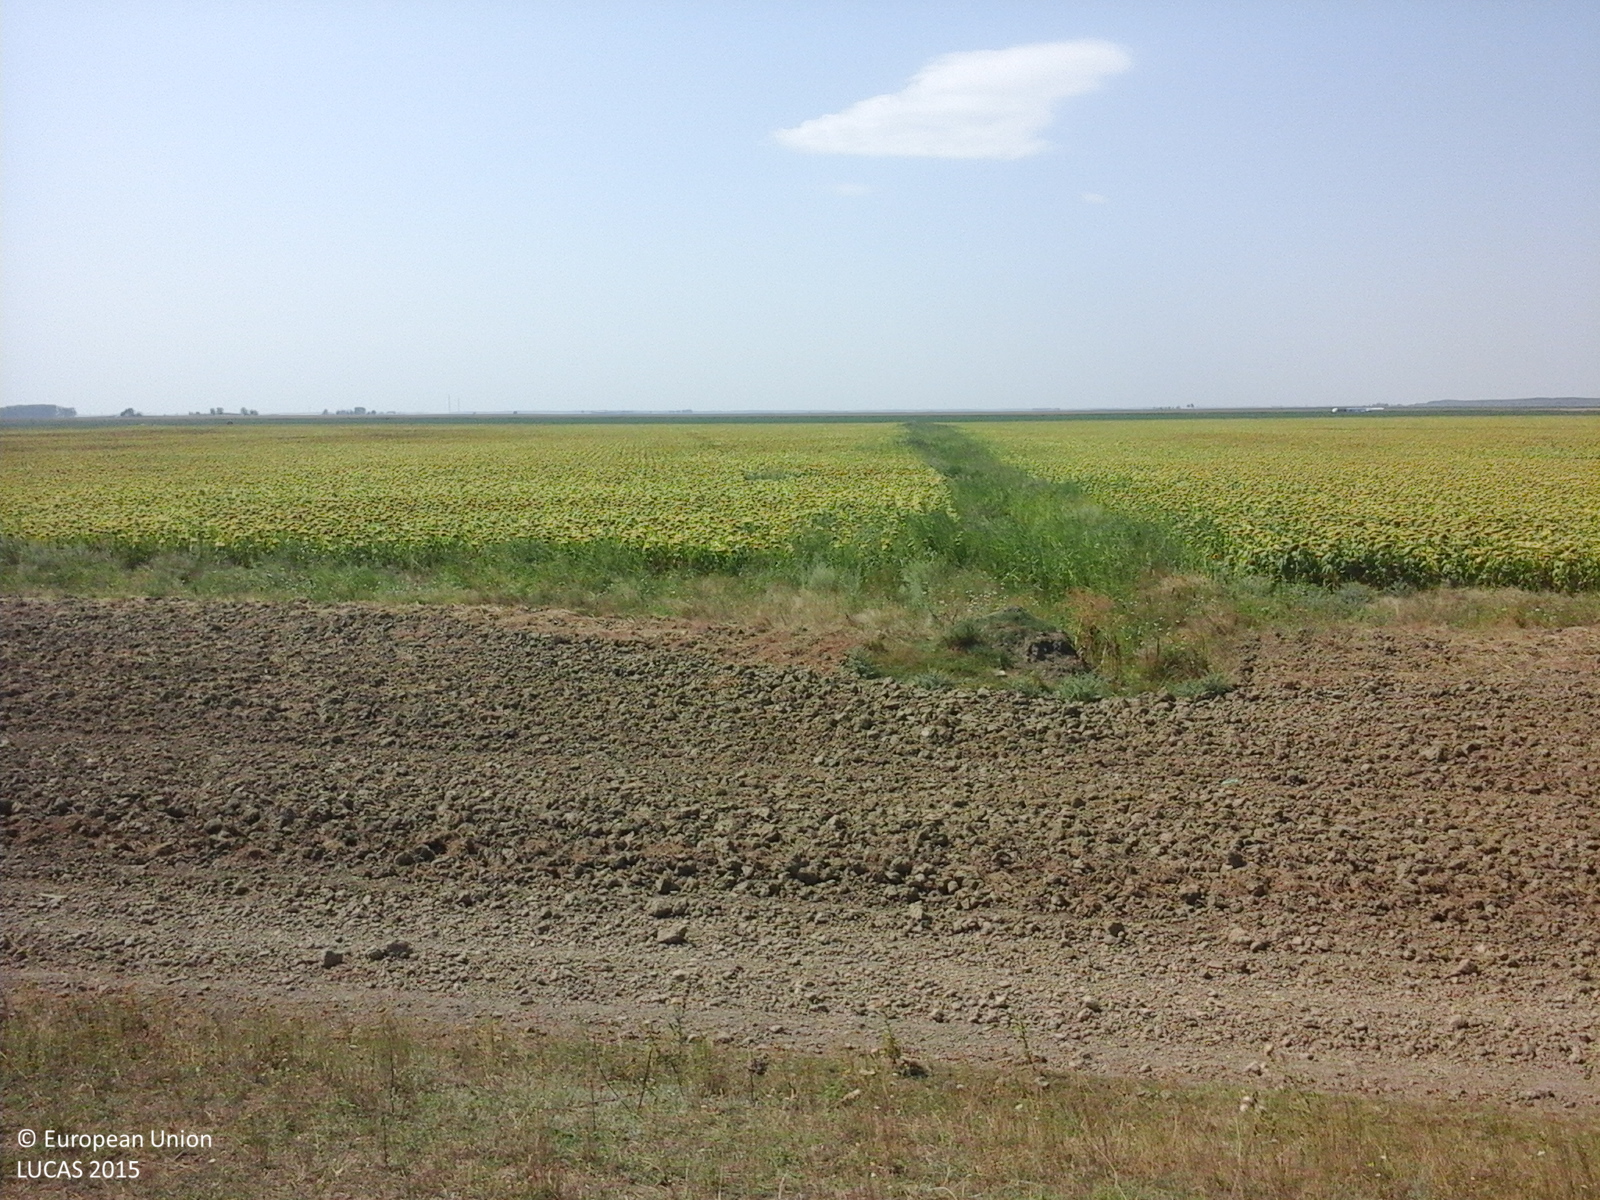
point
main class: Cropland
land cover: Lucerne
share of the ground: > 75 %
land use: Agriculture (excluding fallow land and kitchen gardens)
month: August
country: RO
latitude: 45.1299
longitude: 28.1612
